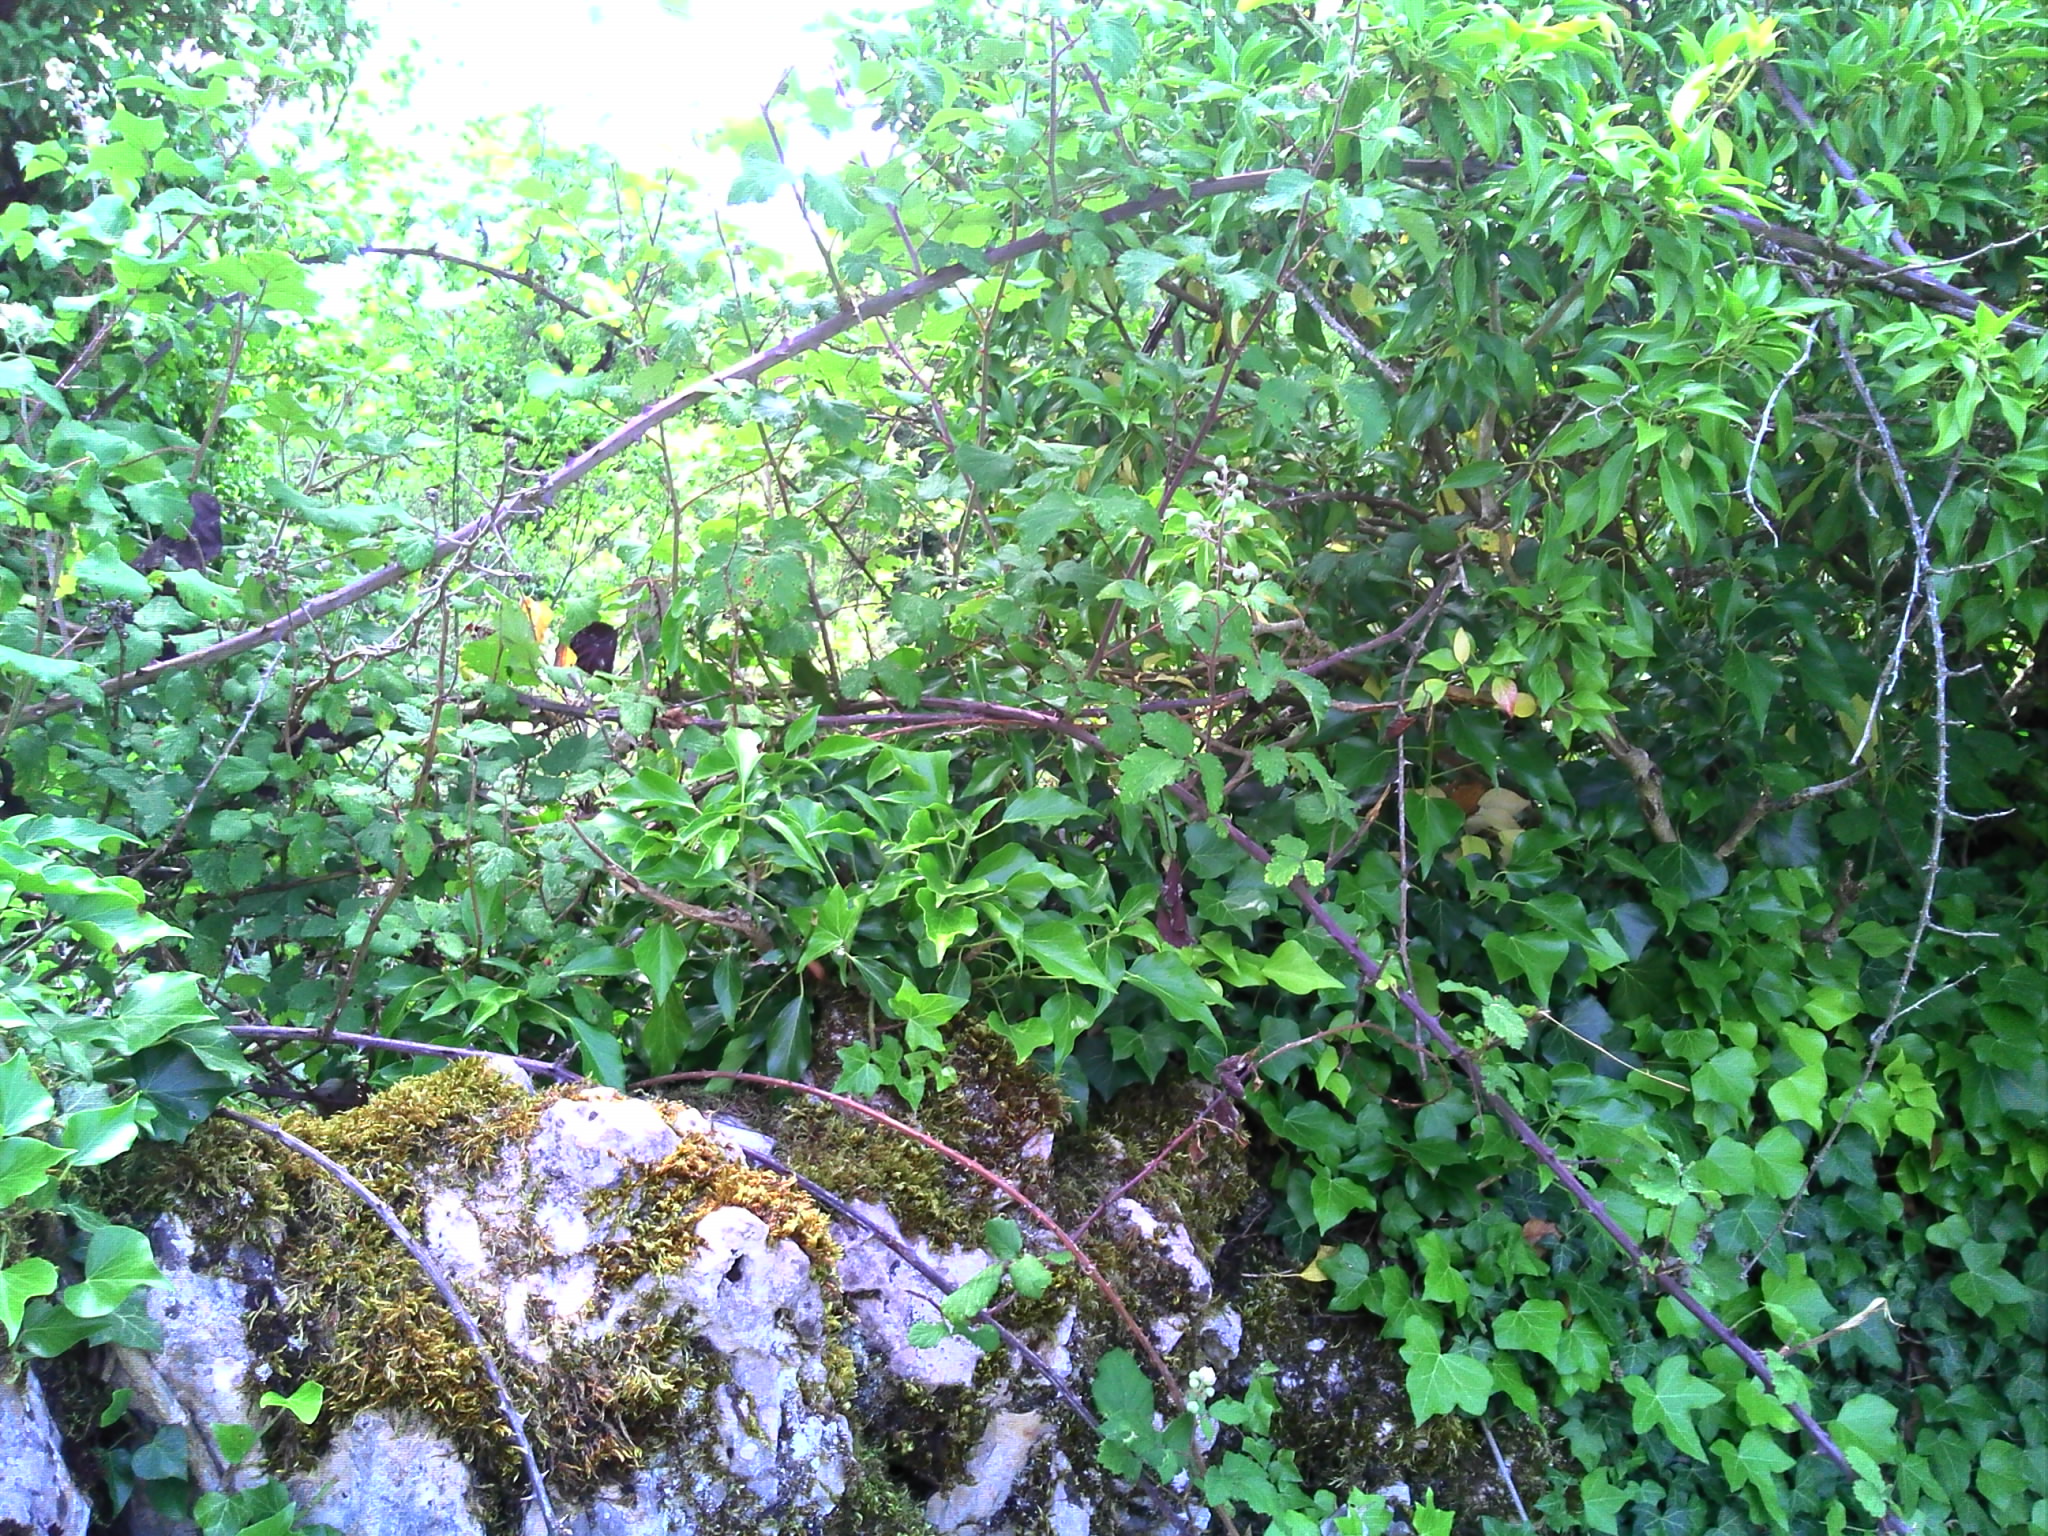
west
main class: Grassland
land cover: Grassland without tree/shrub cover
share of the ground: > 75 %
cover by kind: herbaceous plants 100 %
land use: Agriculture (excluding fallow land and kitchen gardens)
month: June
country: FR
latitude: 44.8917
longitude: 1.7547
